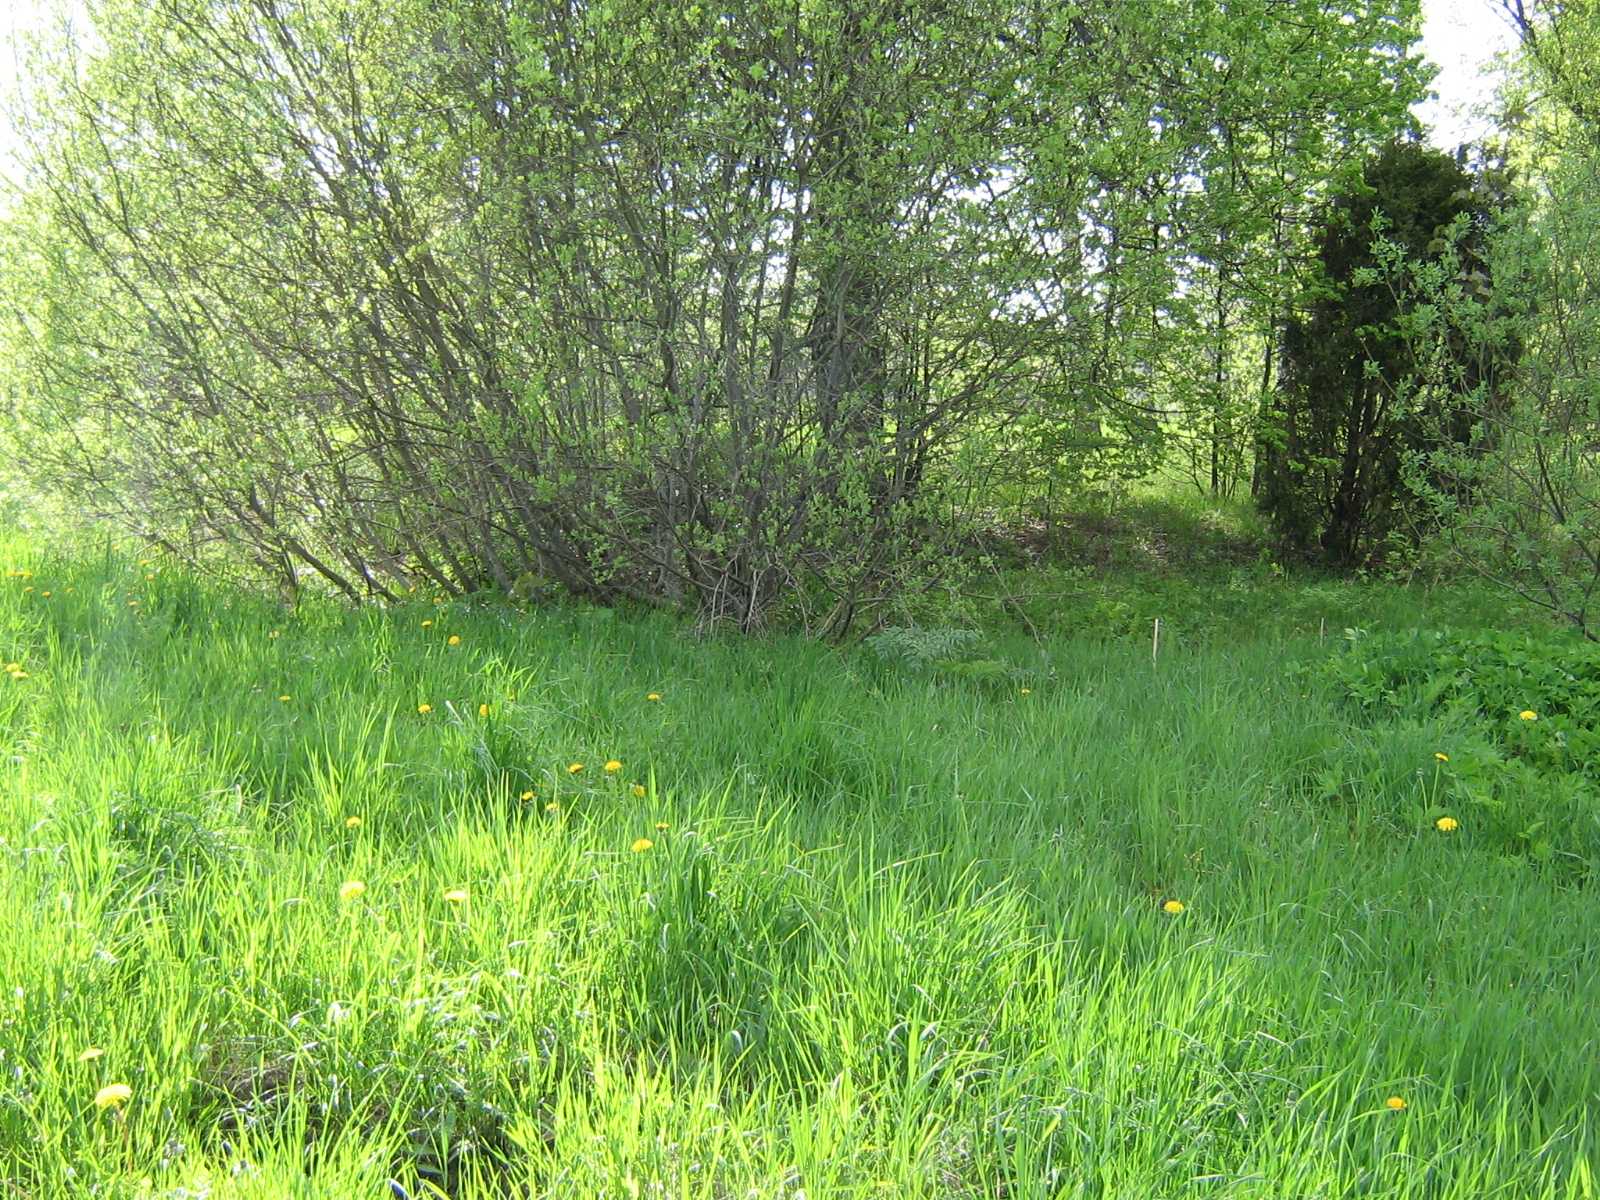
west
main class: Grassland
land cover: Grassland without tree/shrub cover
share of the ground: > 75 %
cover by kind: herbaceous plants 100 %
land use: Agriculture (excluding fallow land and kitchen gardens)
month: May
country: LV
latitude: 57.2777
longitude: 25.9347
